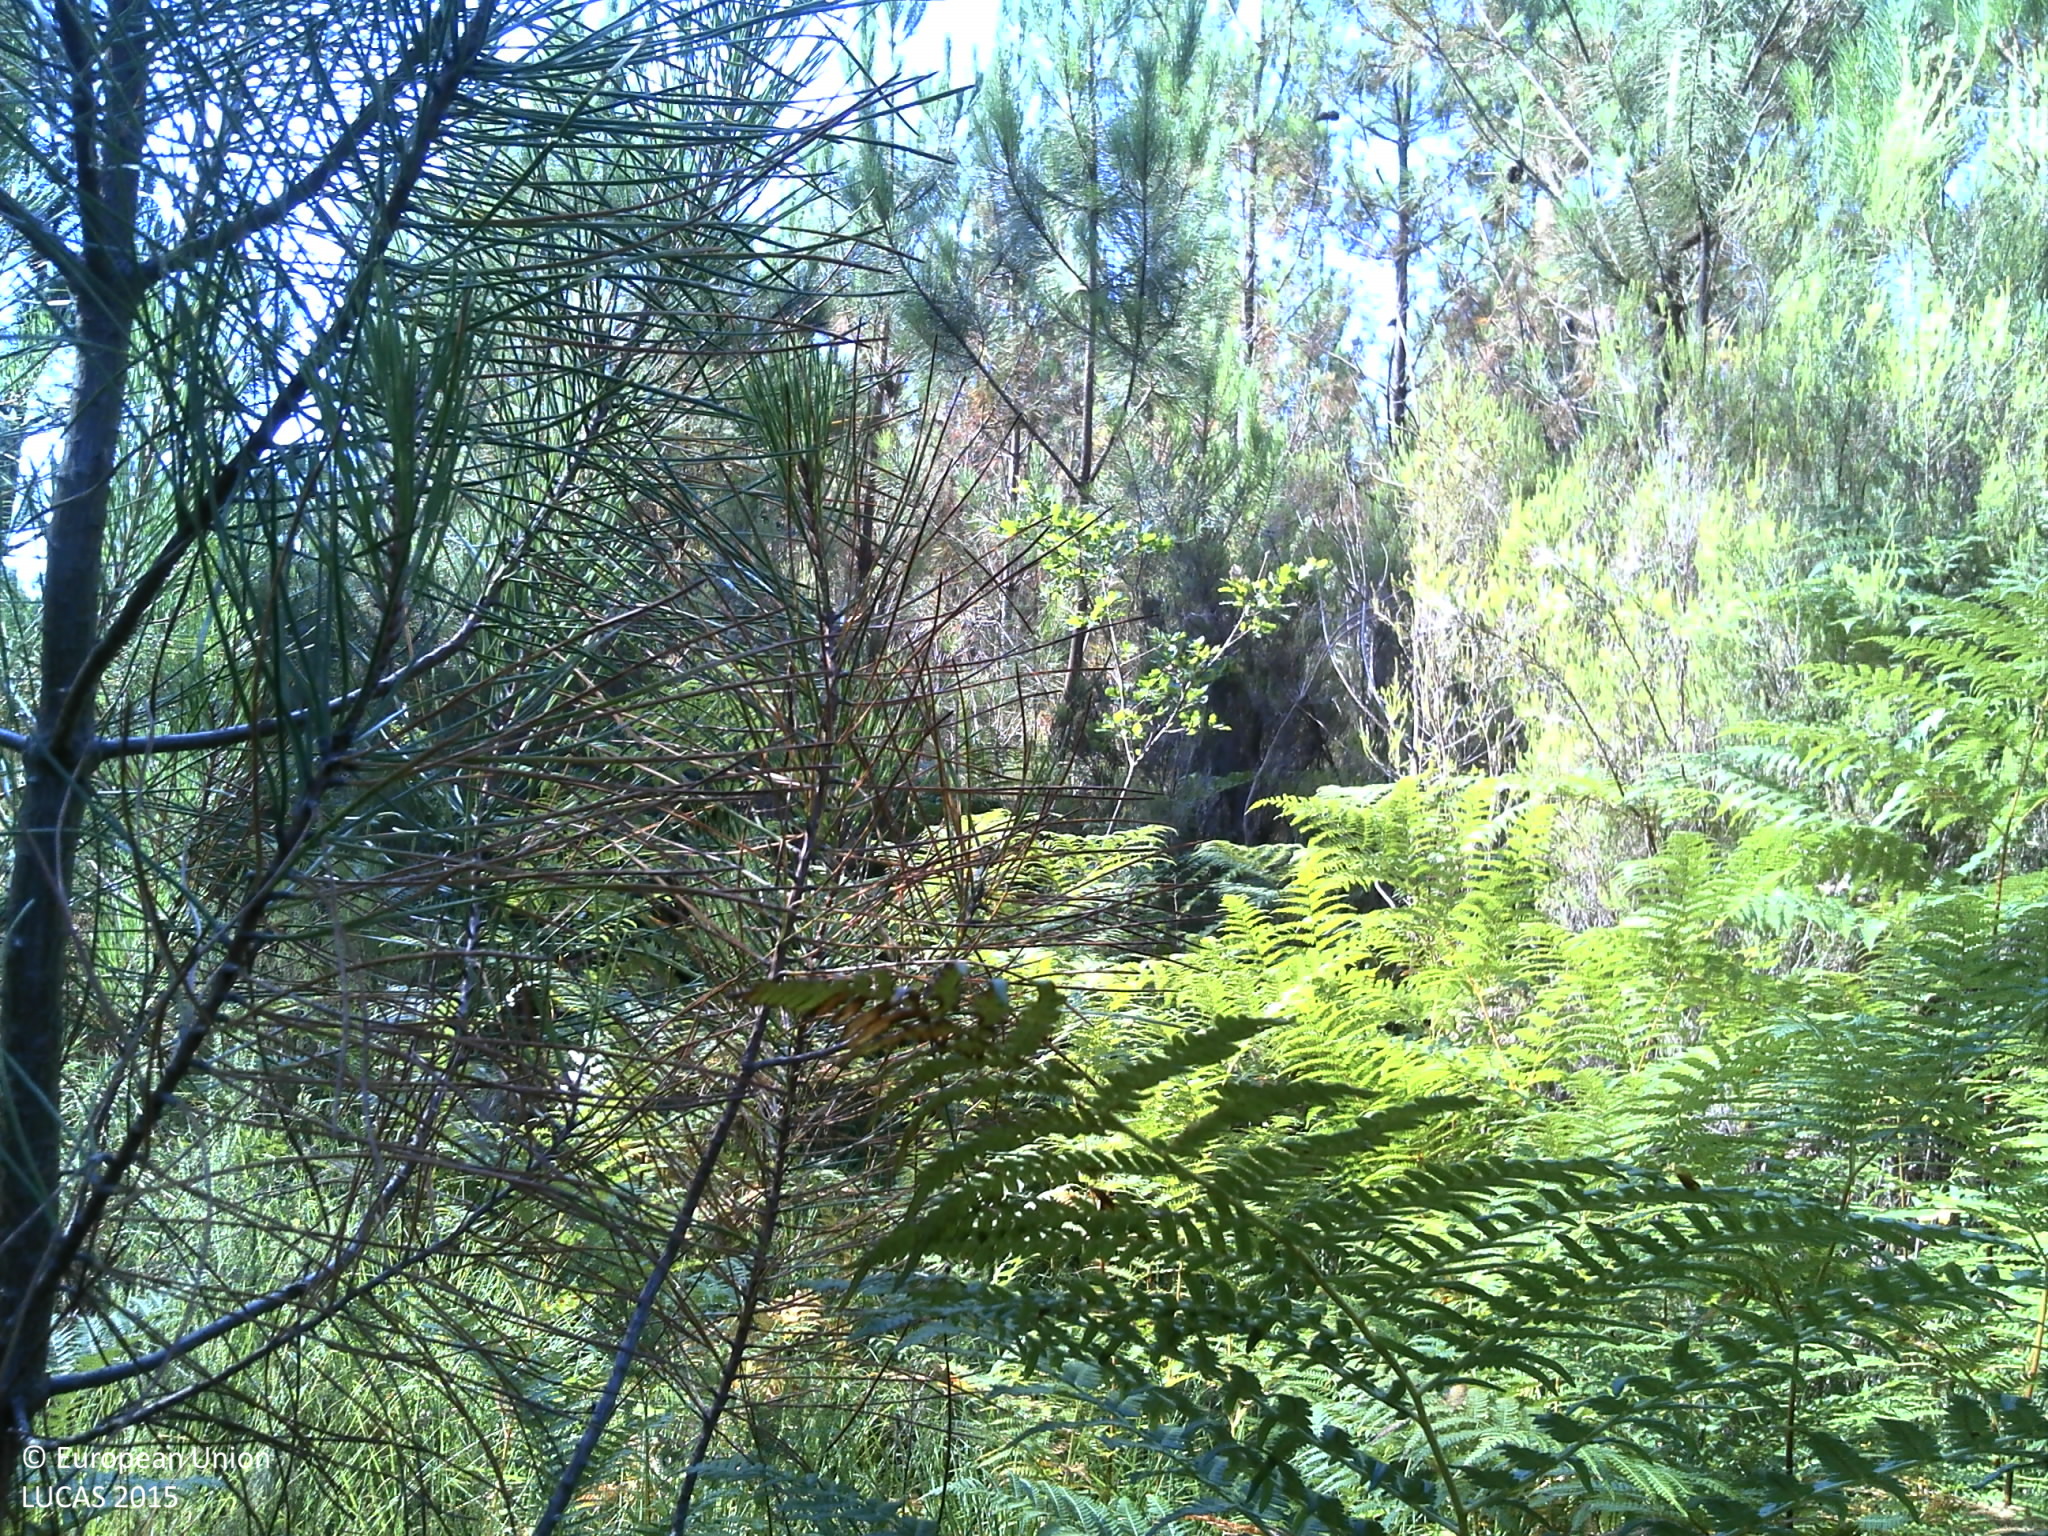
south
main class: Woodland
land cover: Pine dominated coniferous woodland
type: coniferous forest of the mediterranean region
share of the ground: > 75 %
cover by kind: coniferous forest trees 60 %, shrubs 30 %, herbaceous plants 5 %, lichens and mosses 5 %
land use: Forestry
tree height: > 5 m
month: August
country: FR
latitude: 45.0569
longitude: -0.9826
